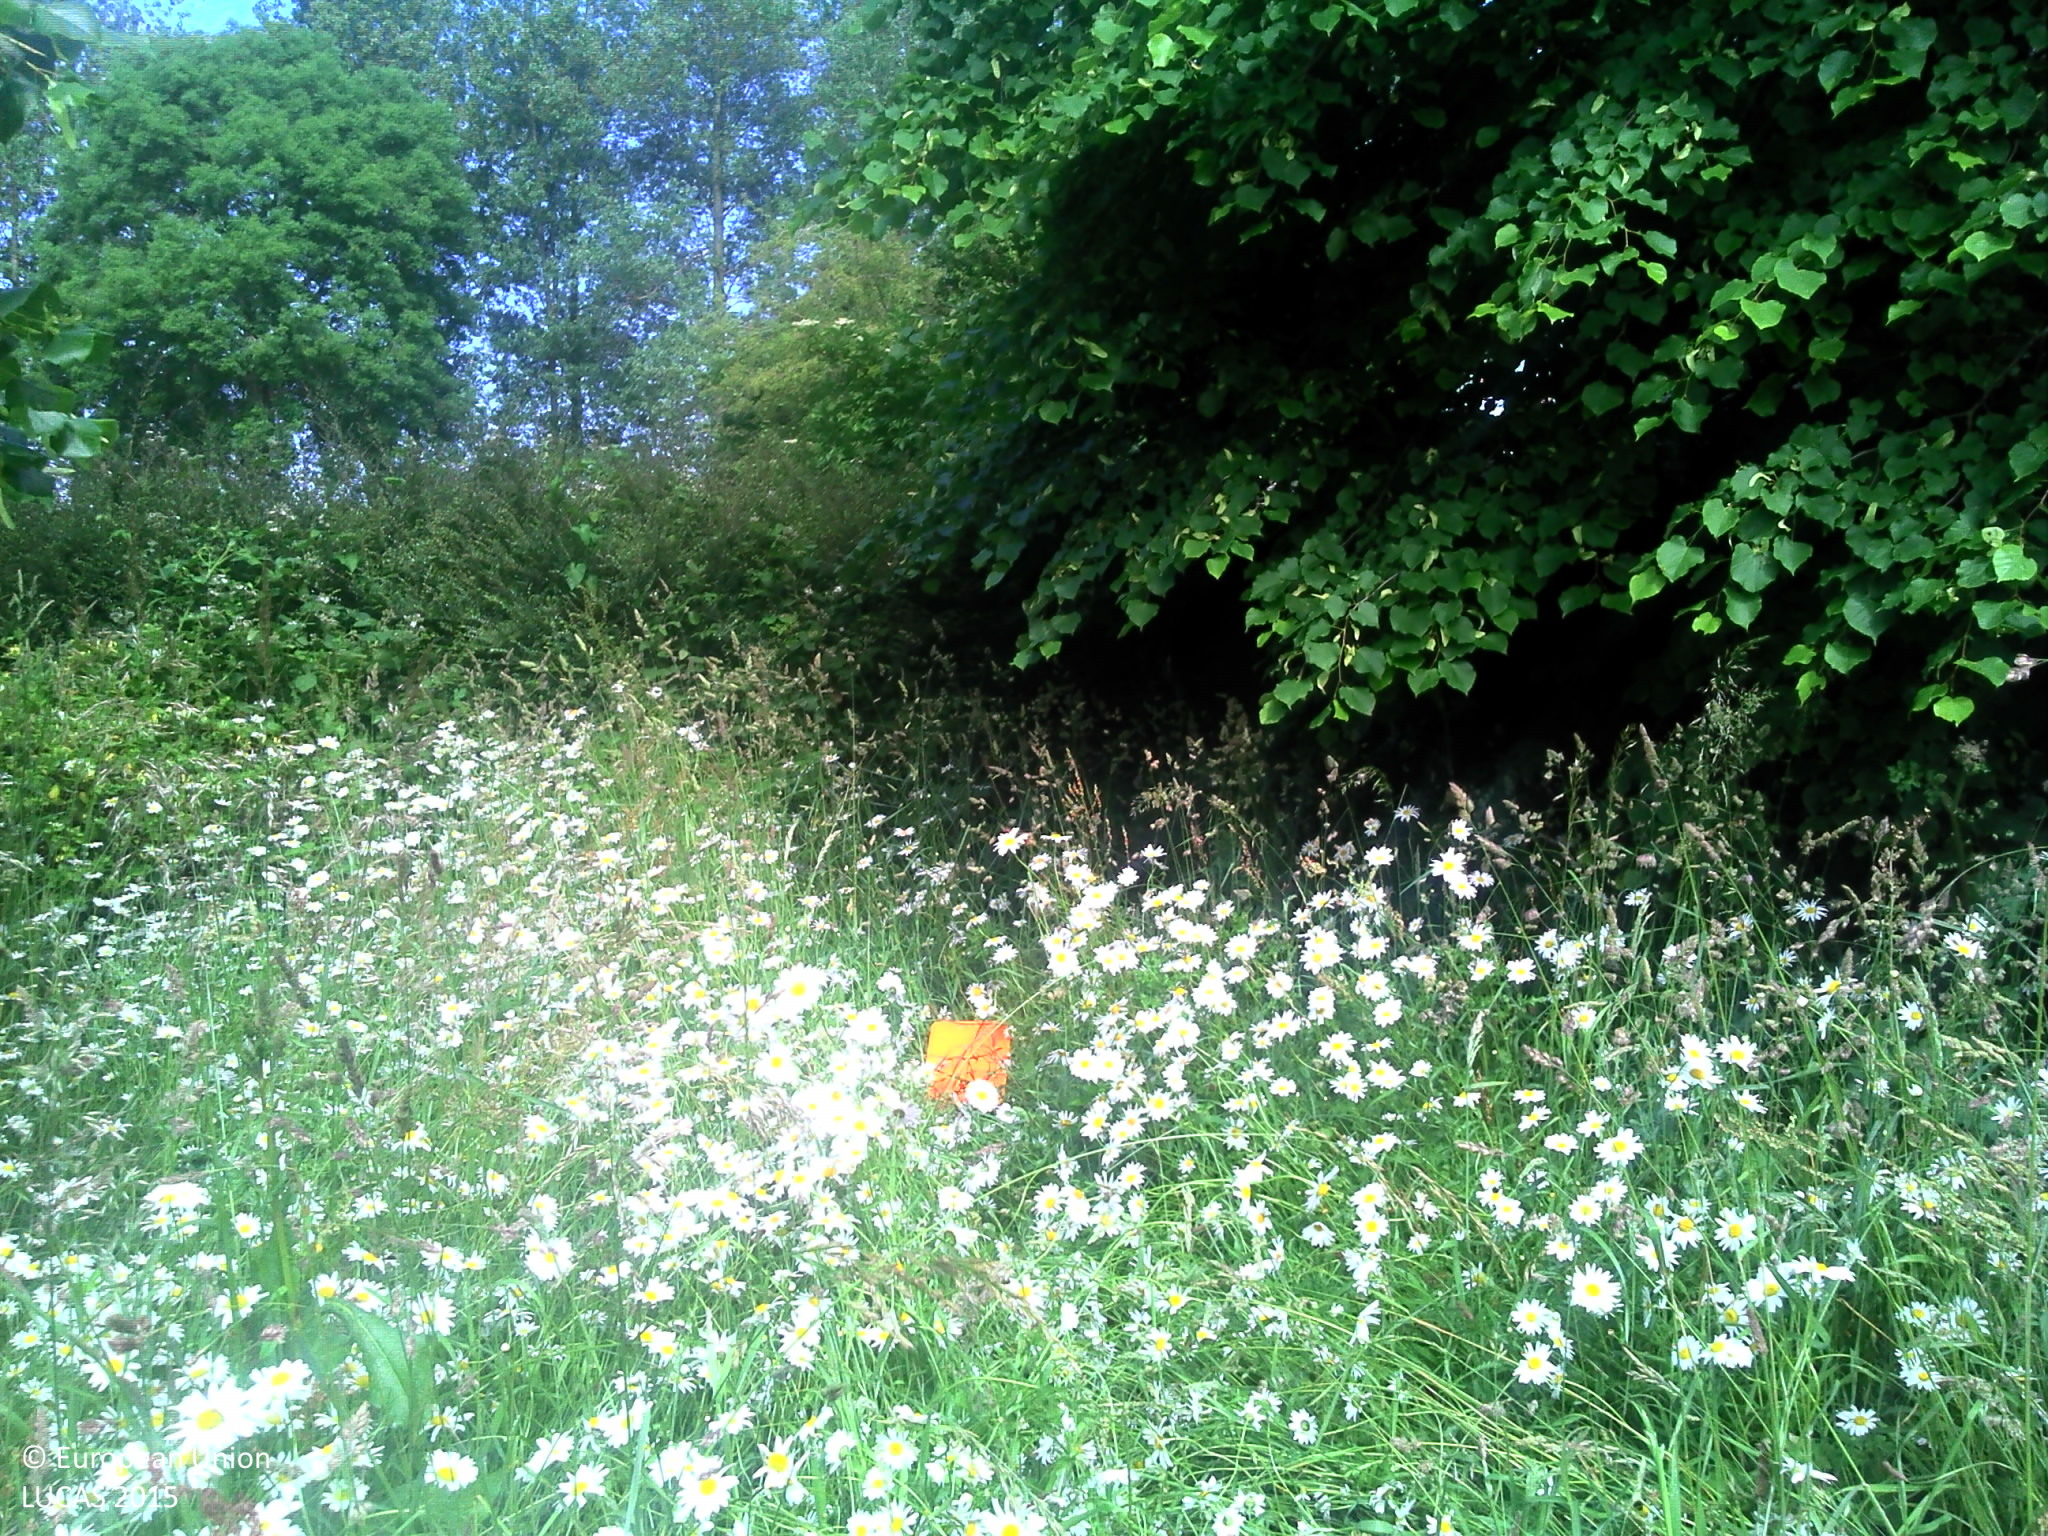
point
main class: Grassland
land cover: Grassland with sparse tree/shrub cover
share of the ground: > 75 %
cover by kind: herbaceous plants 95 %, broadleaved forest trees 5 %
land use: Semi-natural and natural areas not in use
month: June
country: FR
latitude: 49.4114
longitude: -1.3912
